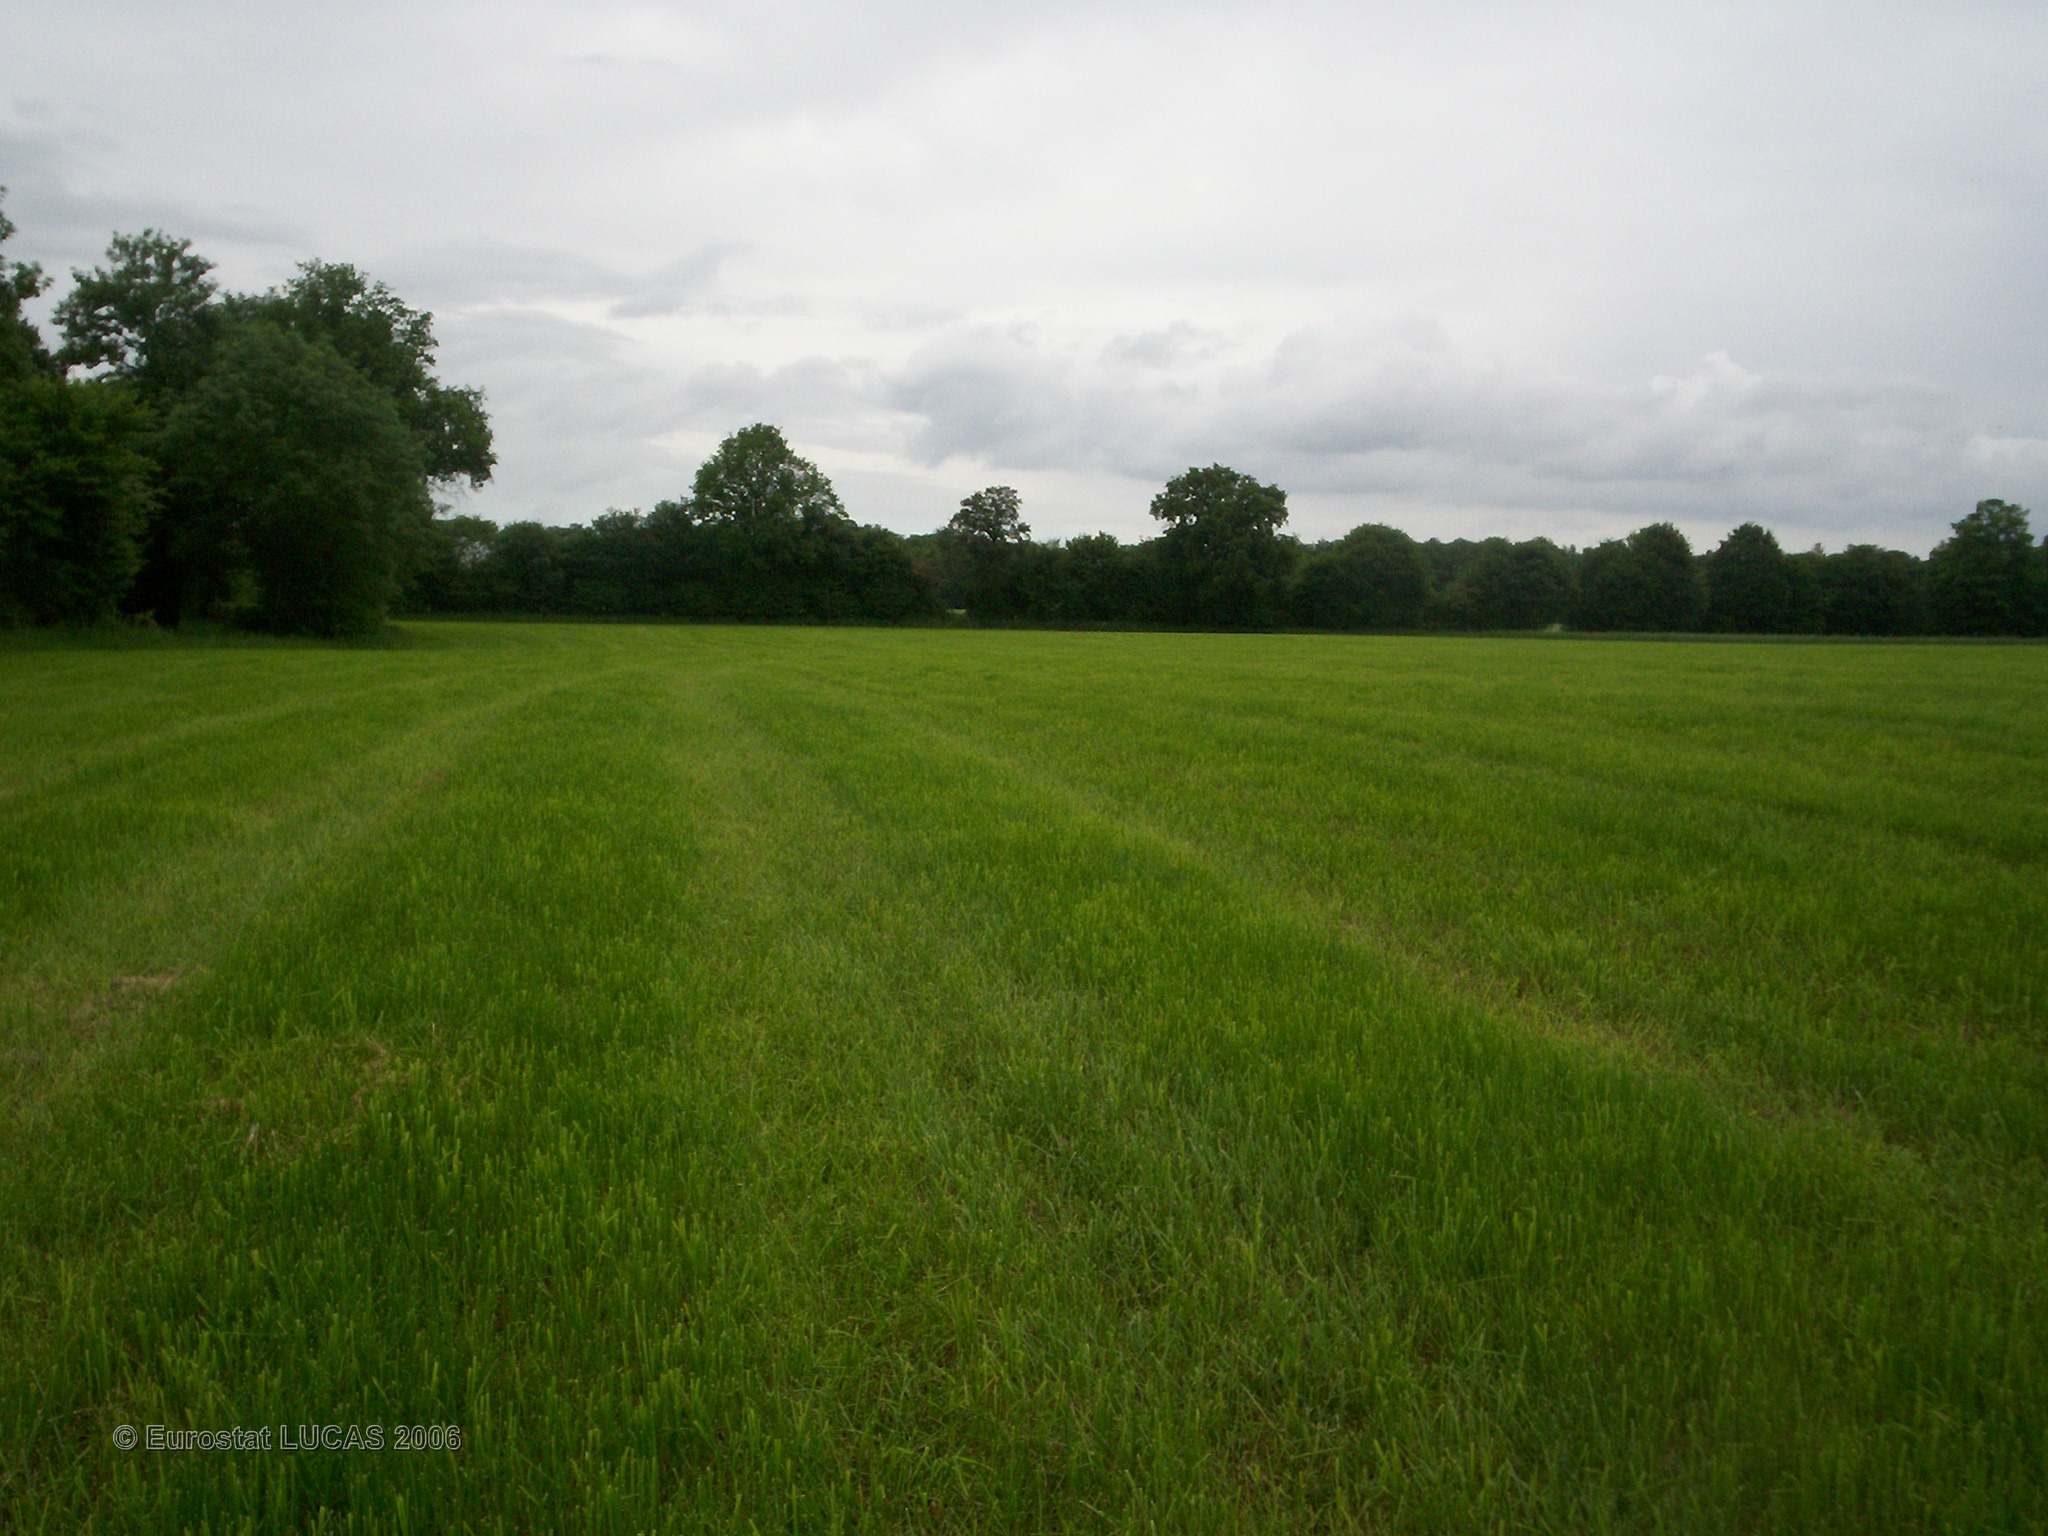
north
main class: Grassland
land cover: Grassland without tree/shrub cover
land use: Agriculture (excluding fallow land and kitchen gardens)
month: May
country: FR
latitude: 47.7961
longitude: 2.9041
